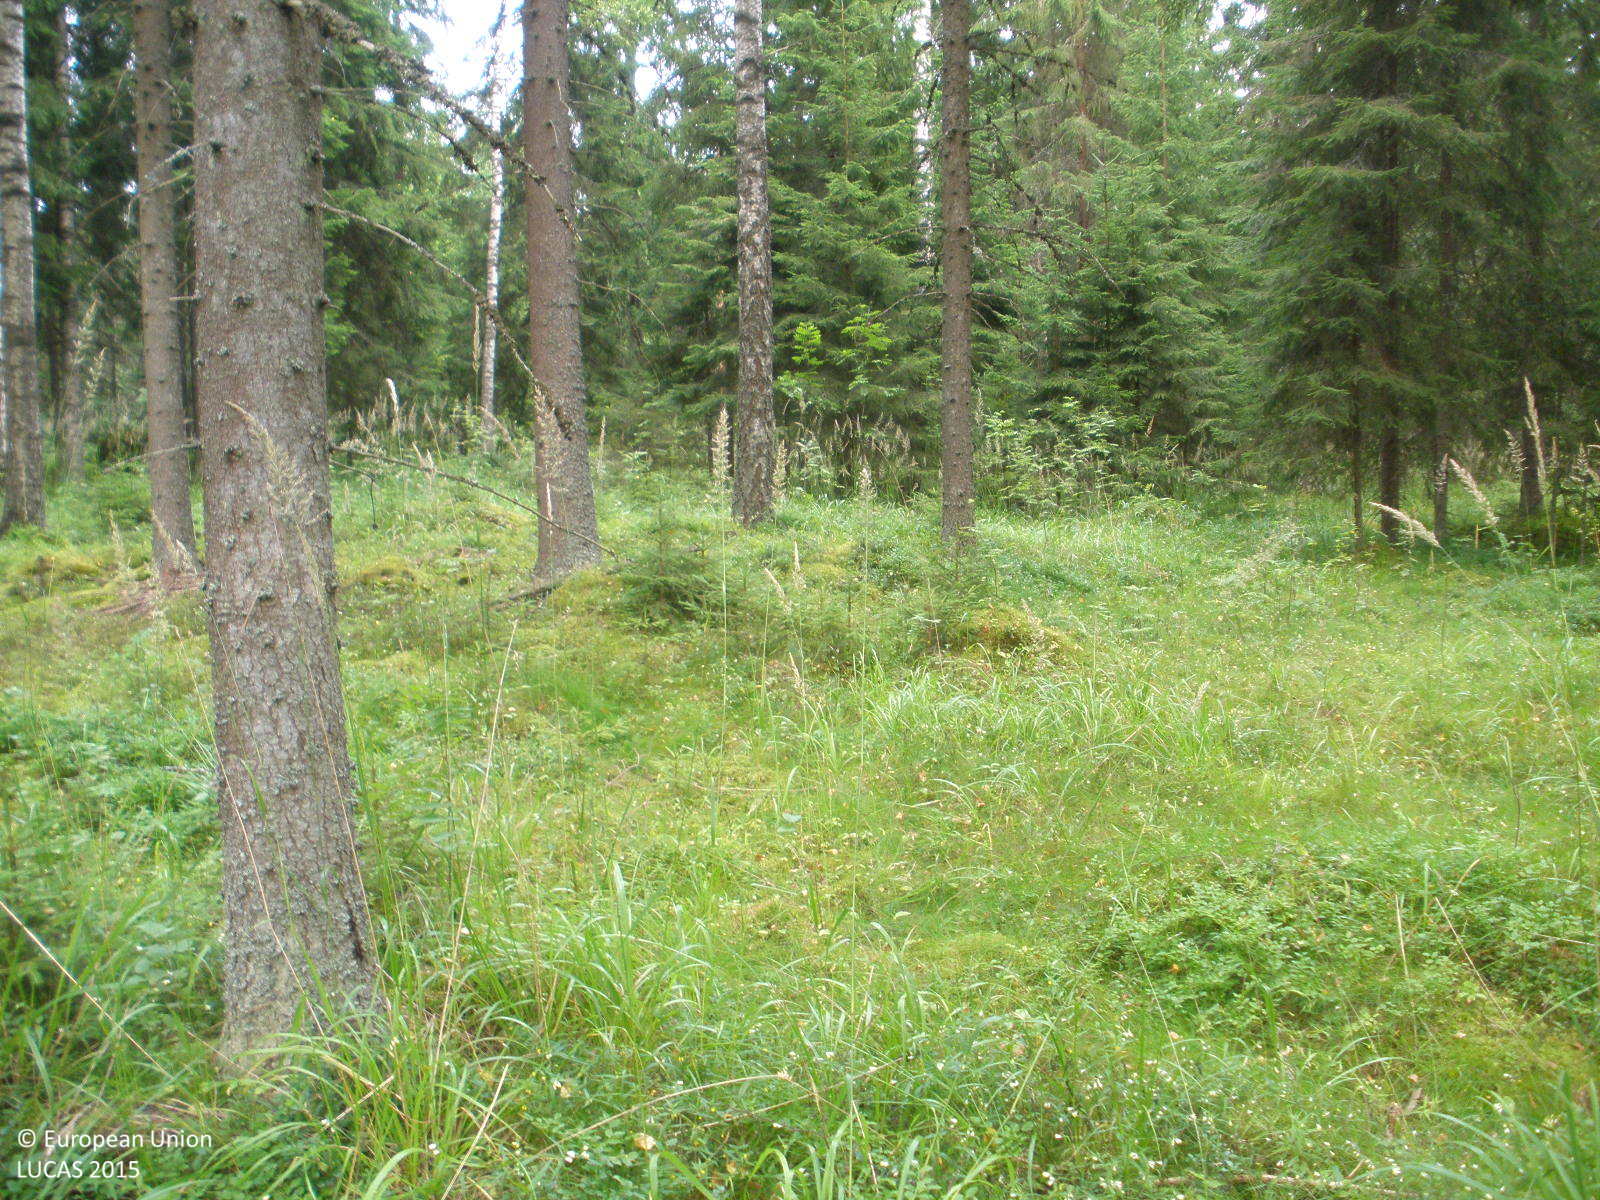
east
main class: Woodland
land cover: Spruce dominated coniferous woodland
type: boreal forest
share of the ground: > 75 %
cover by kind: coniferous forest trees 80 %, herbaceous plants 10 %, broadleaved forest trees 5 %, lichens and mosses 5 %
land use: Forestry
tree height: > 5 m
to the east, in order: Spruce dominated coniferous woodland; Spruce dominated mixed woodland; Spruce dominated coniferous woodland; Ditches and canals; Spruce dominated coniferous woodland
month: August
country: FI
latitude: 60.7365
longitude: 24.4259
